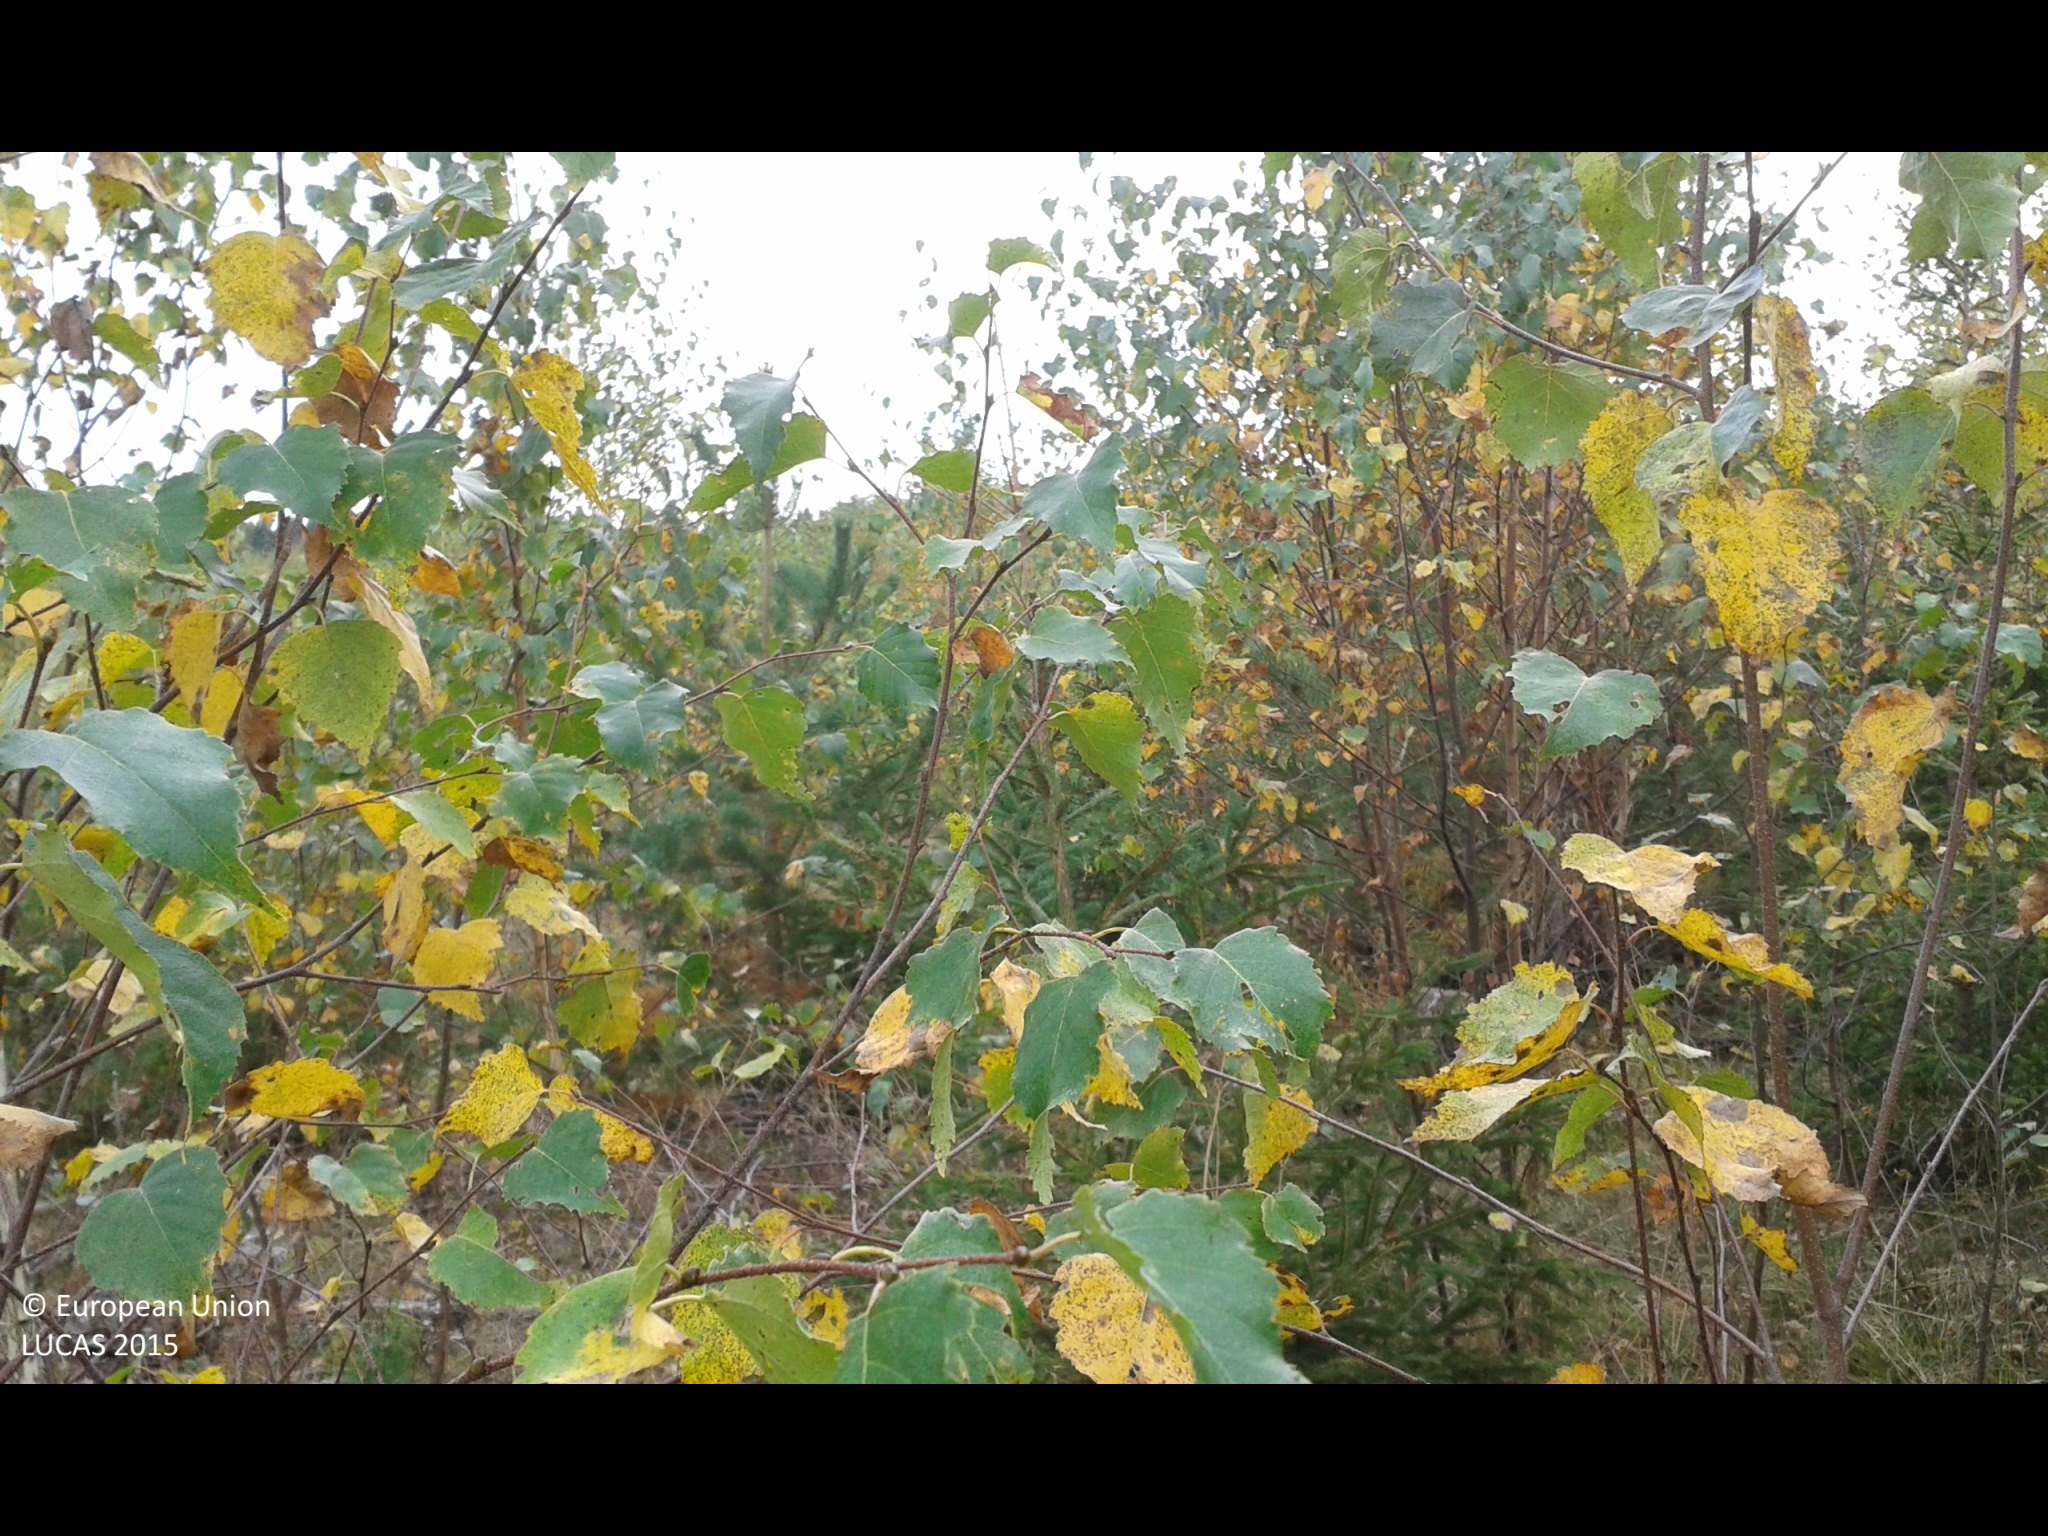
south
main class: Woodland
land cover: Spruce dominated mixed woodland
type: boreal forest
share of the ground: 50 - 75 %
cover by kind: coniferous forest trees 45 %, herbaceous plants 40 %, broadleaved forest trees 15 %
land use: Forestry
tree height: < 5 m
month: October
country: SE
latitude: 58.8832
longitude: 17.0573
